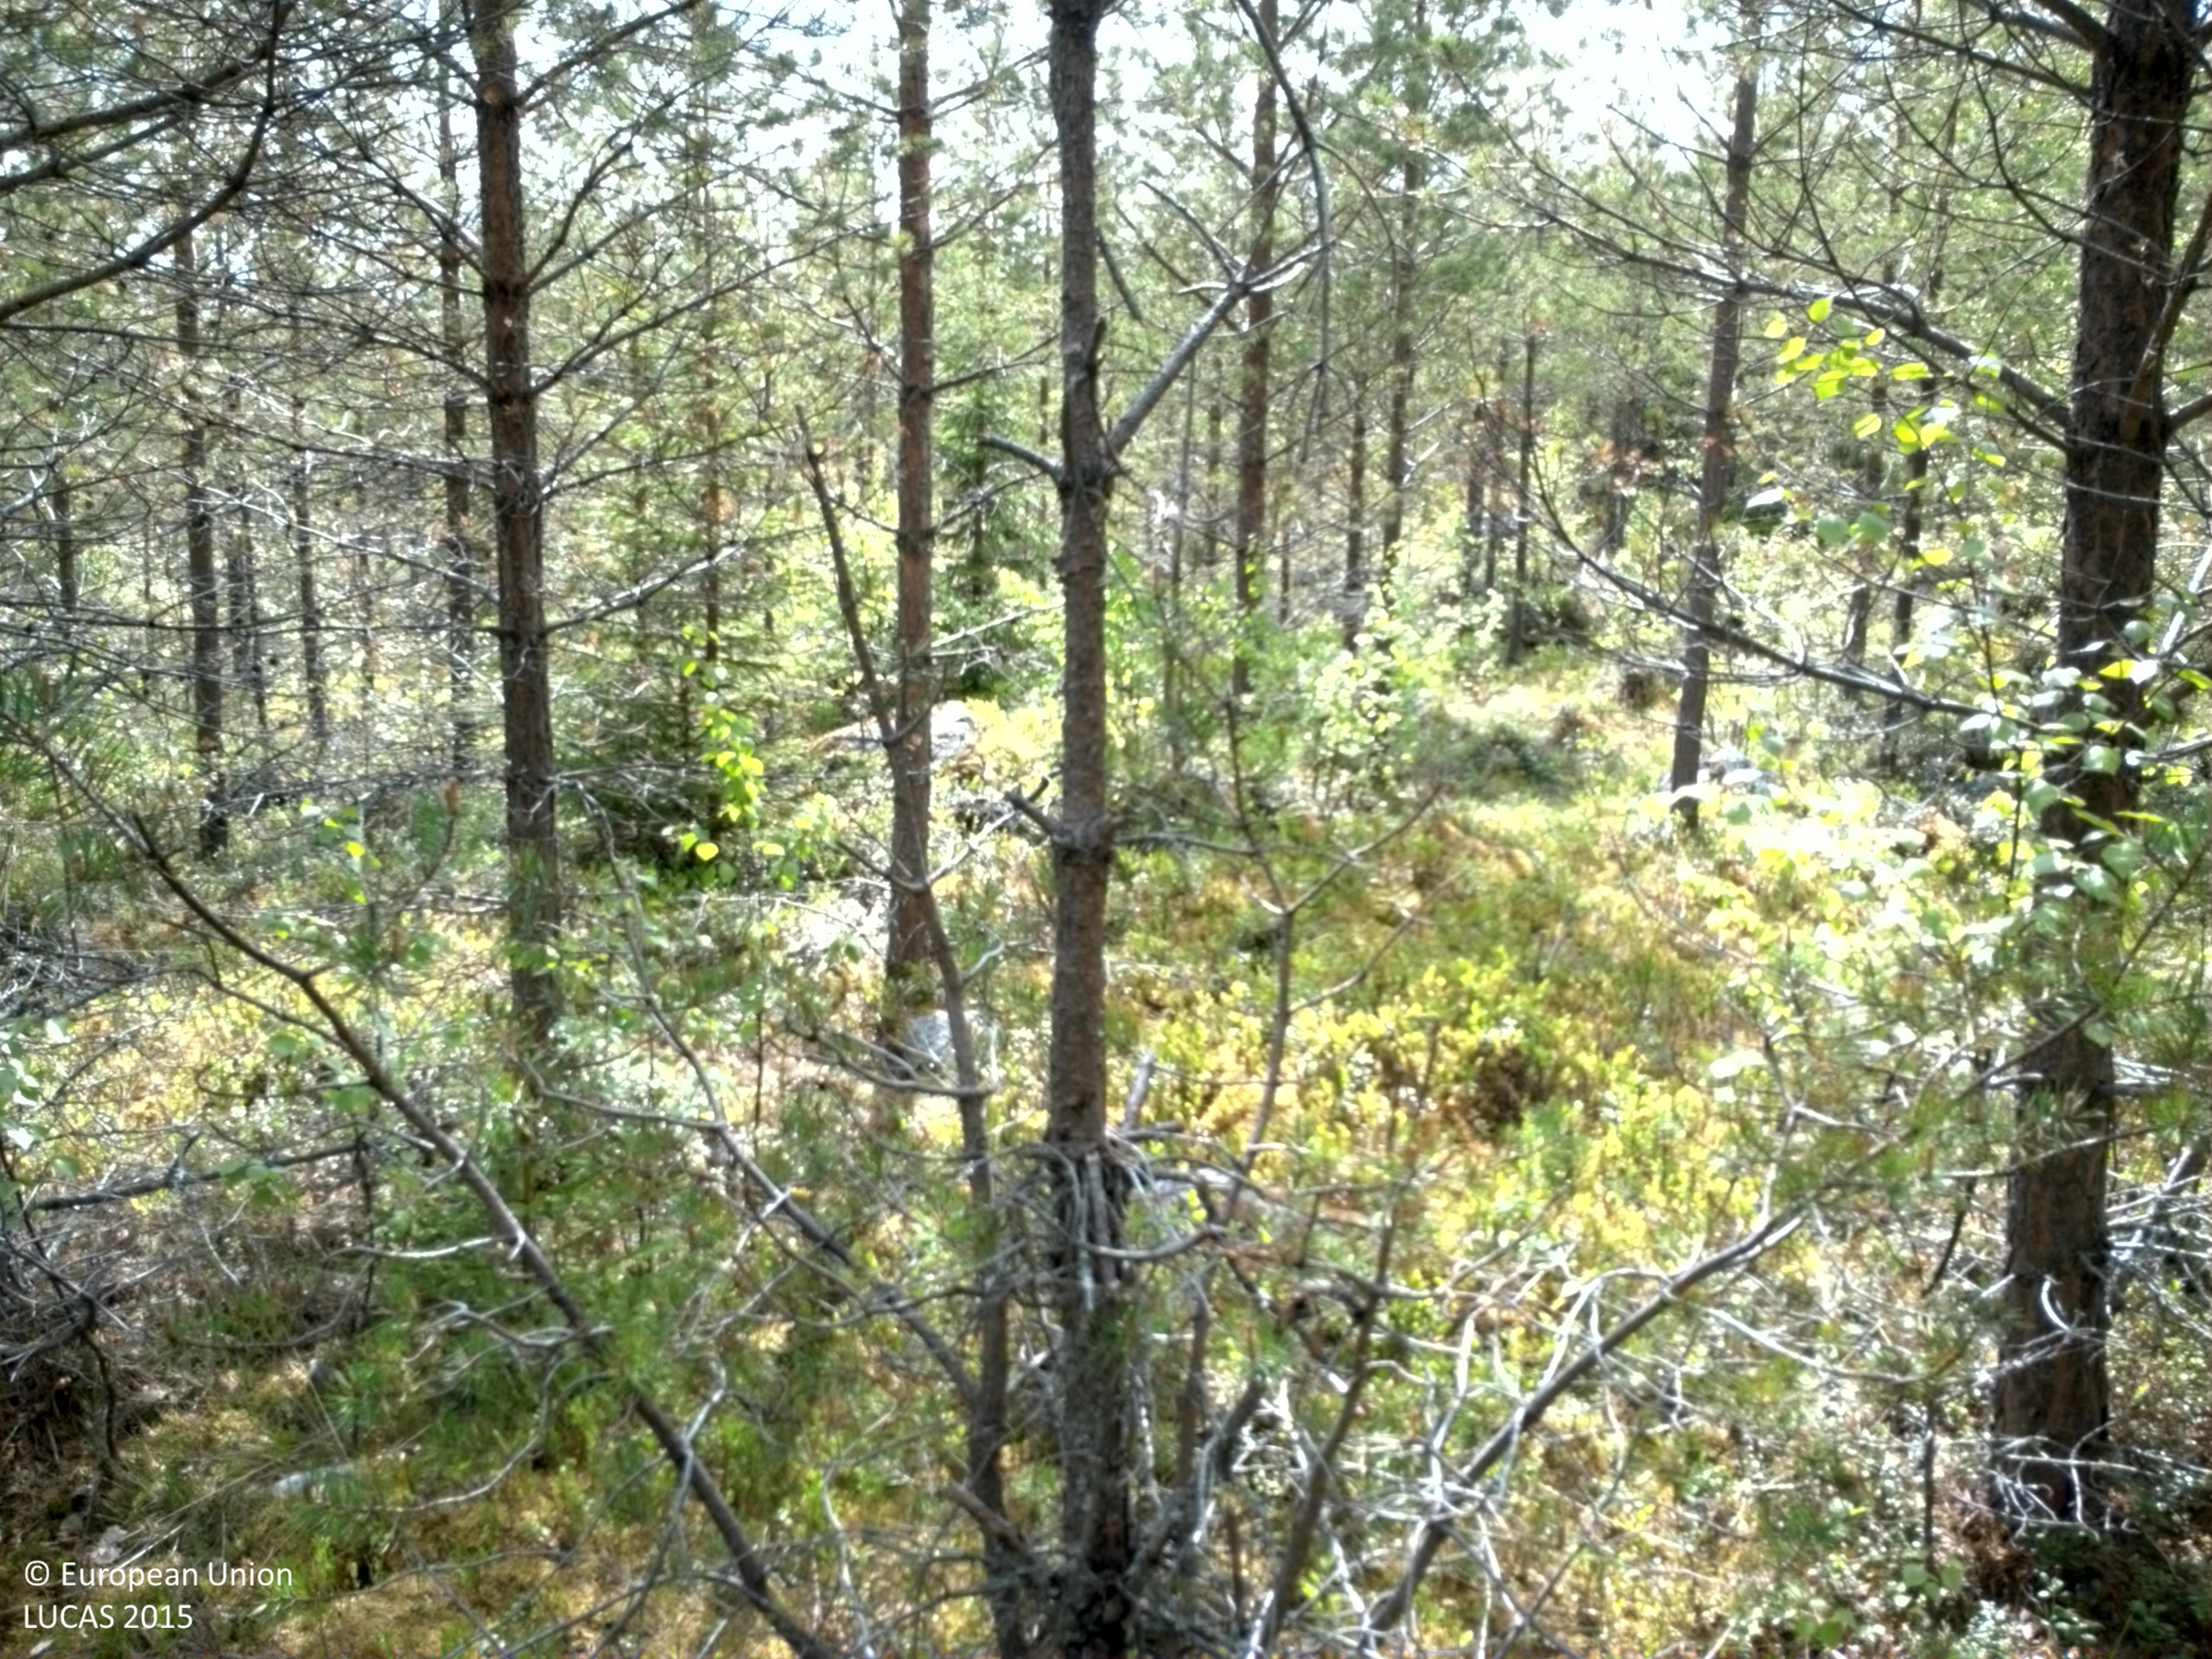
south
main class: Woodland
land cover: Pine dominated coniferous woodland
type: boreal forest
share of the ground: > 75 %
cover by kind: coniferous forest trees 85 %, shrubs 15 %
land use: Forestry
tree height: > 5 m
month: June
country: SE
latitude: 62.9757
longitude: 16.9799
